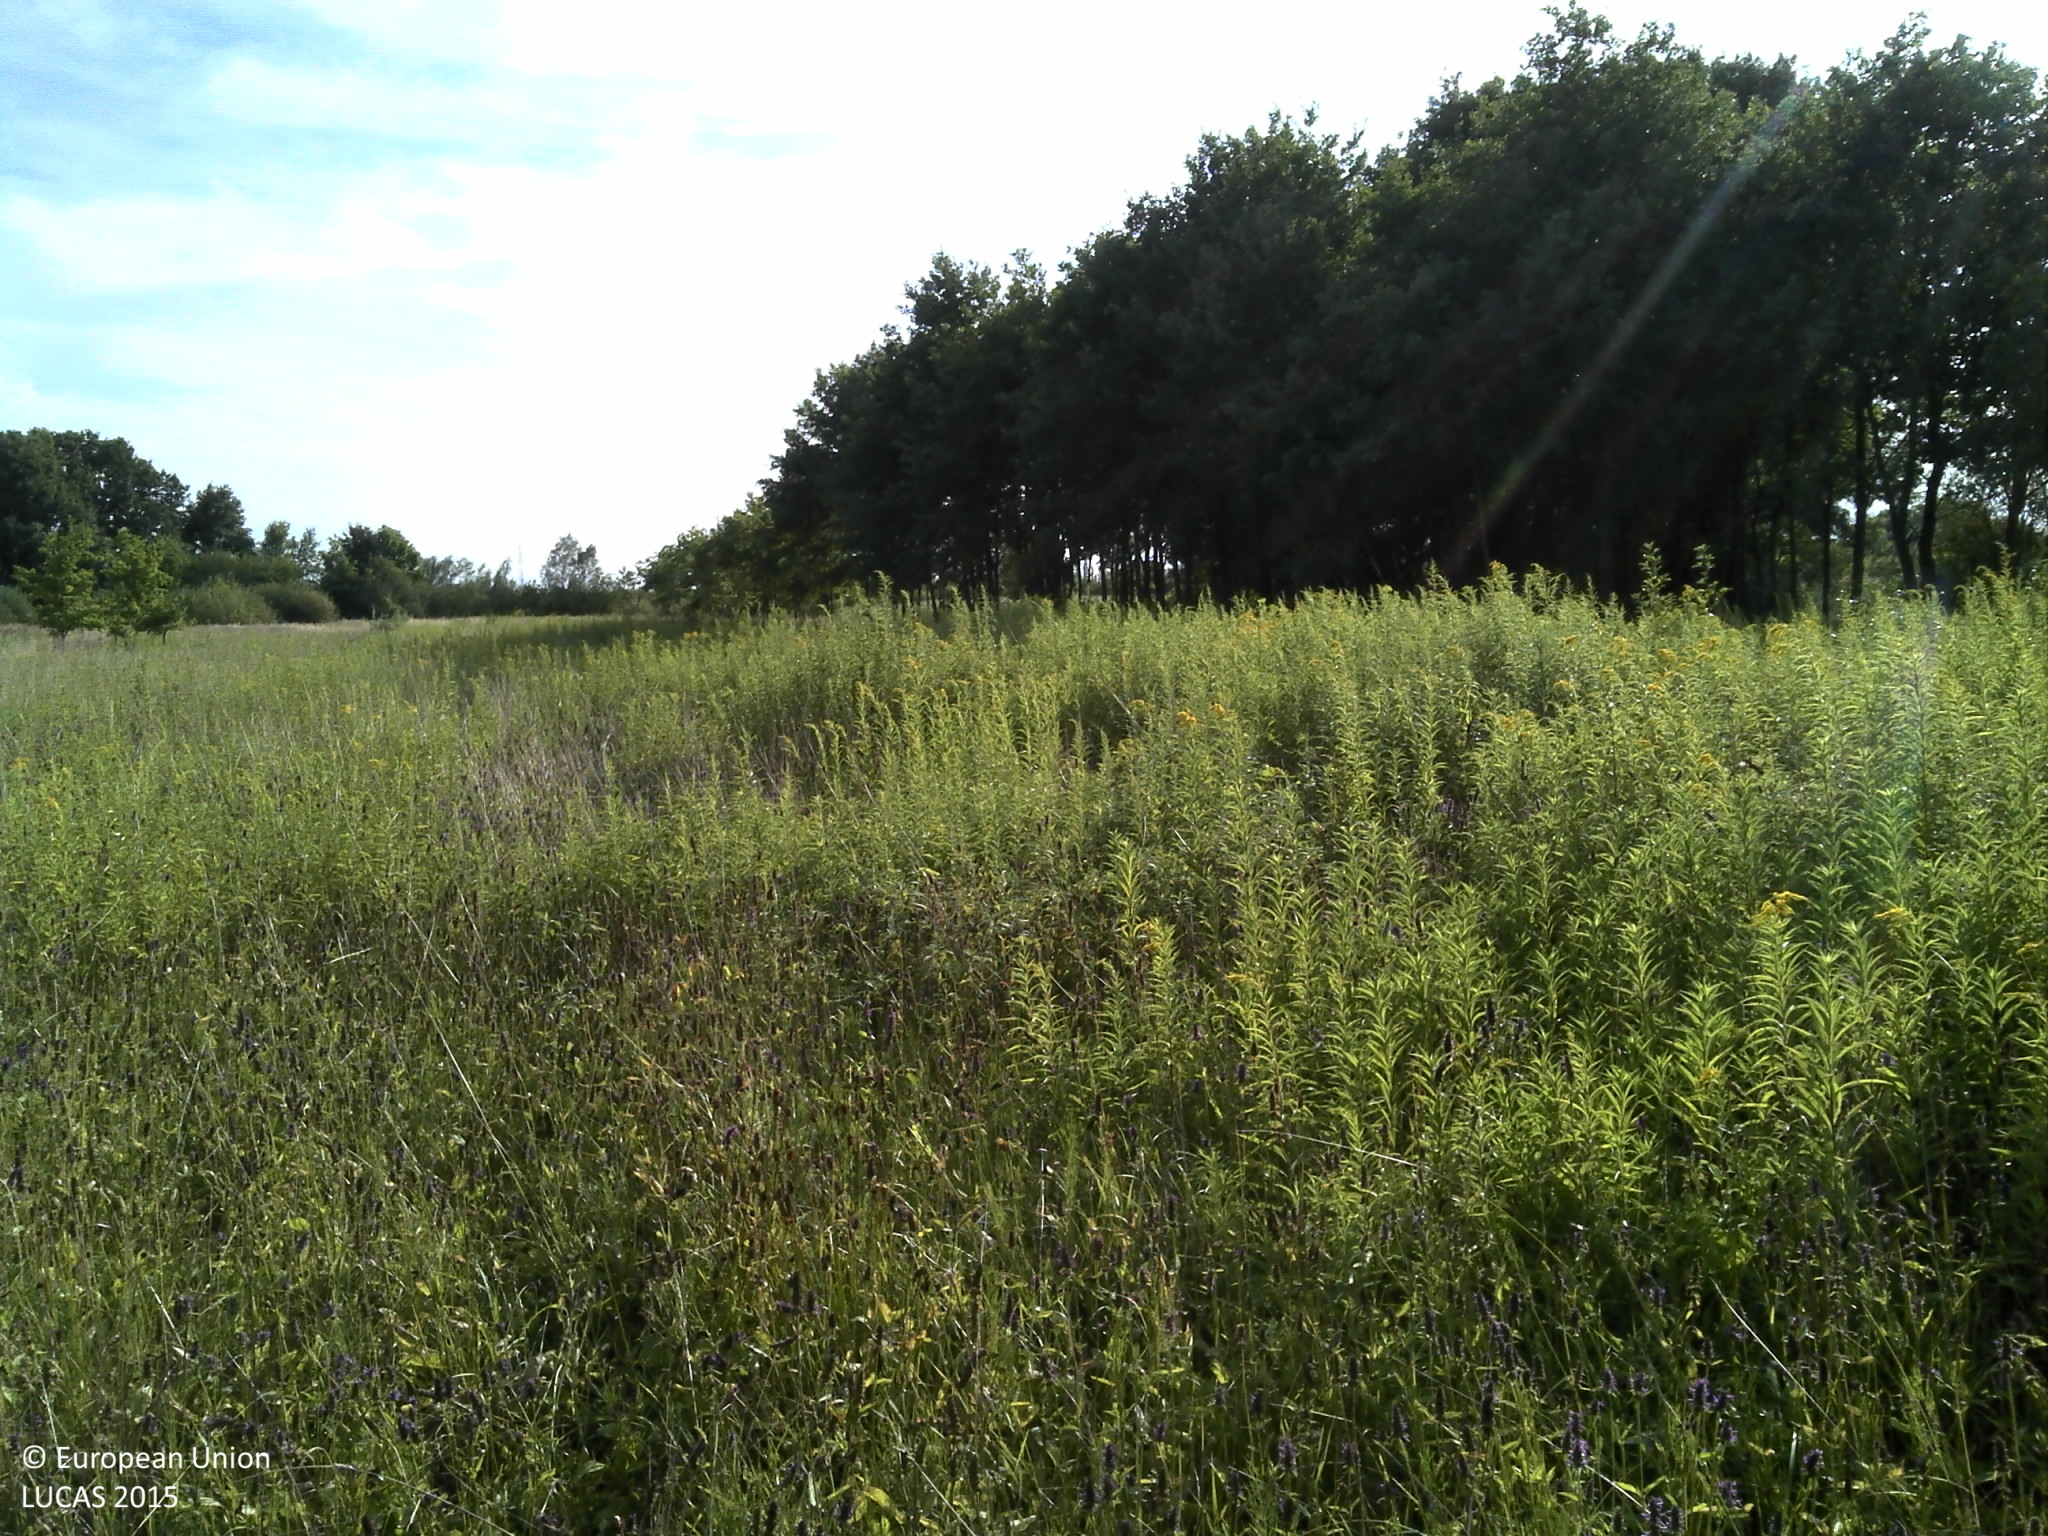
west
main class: Grassland
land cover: Grassland without tree/shrub cover
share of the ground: > 75 %
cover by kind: herbaceous plants 100 %
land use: Agriculture (excluding fallow land and kitchen gardens)
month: July
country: HR
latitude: 45.6066
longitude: 16.5764
